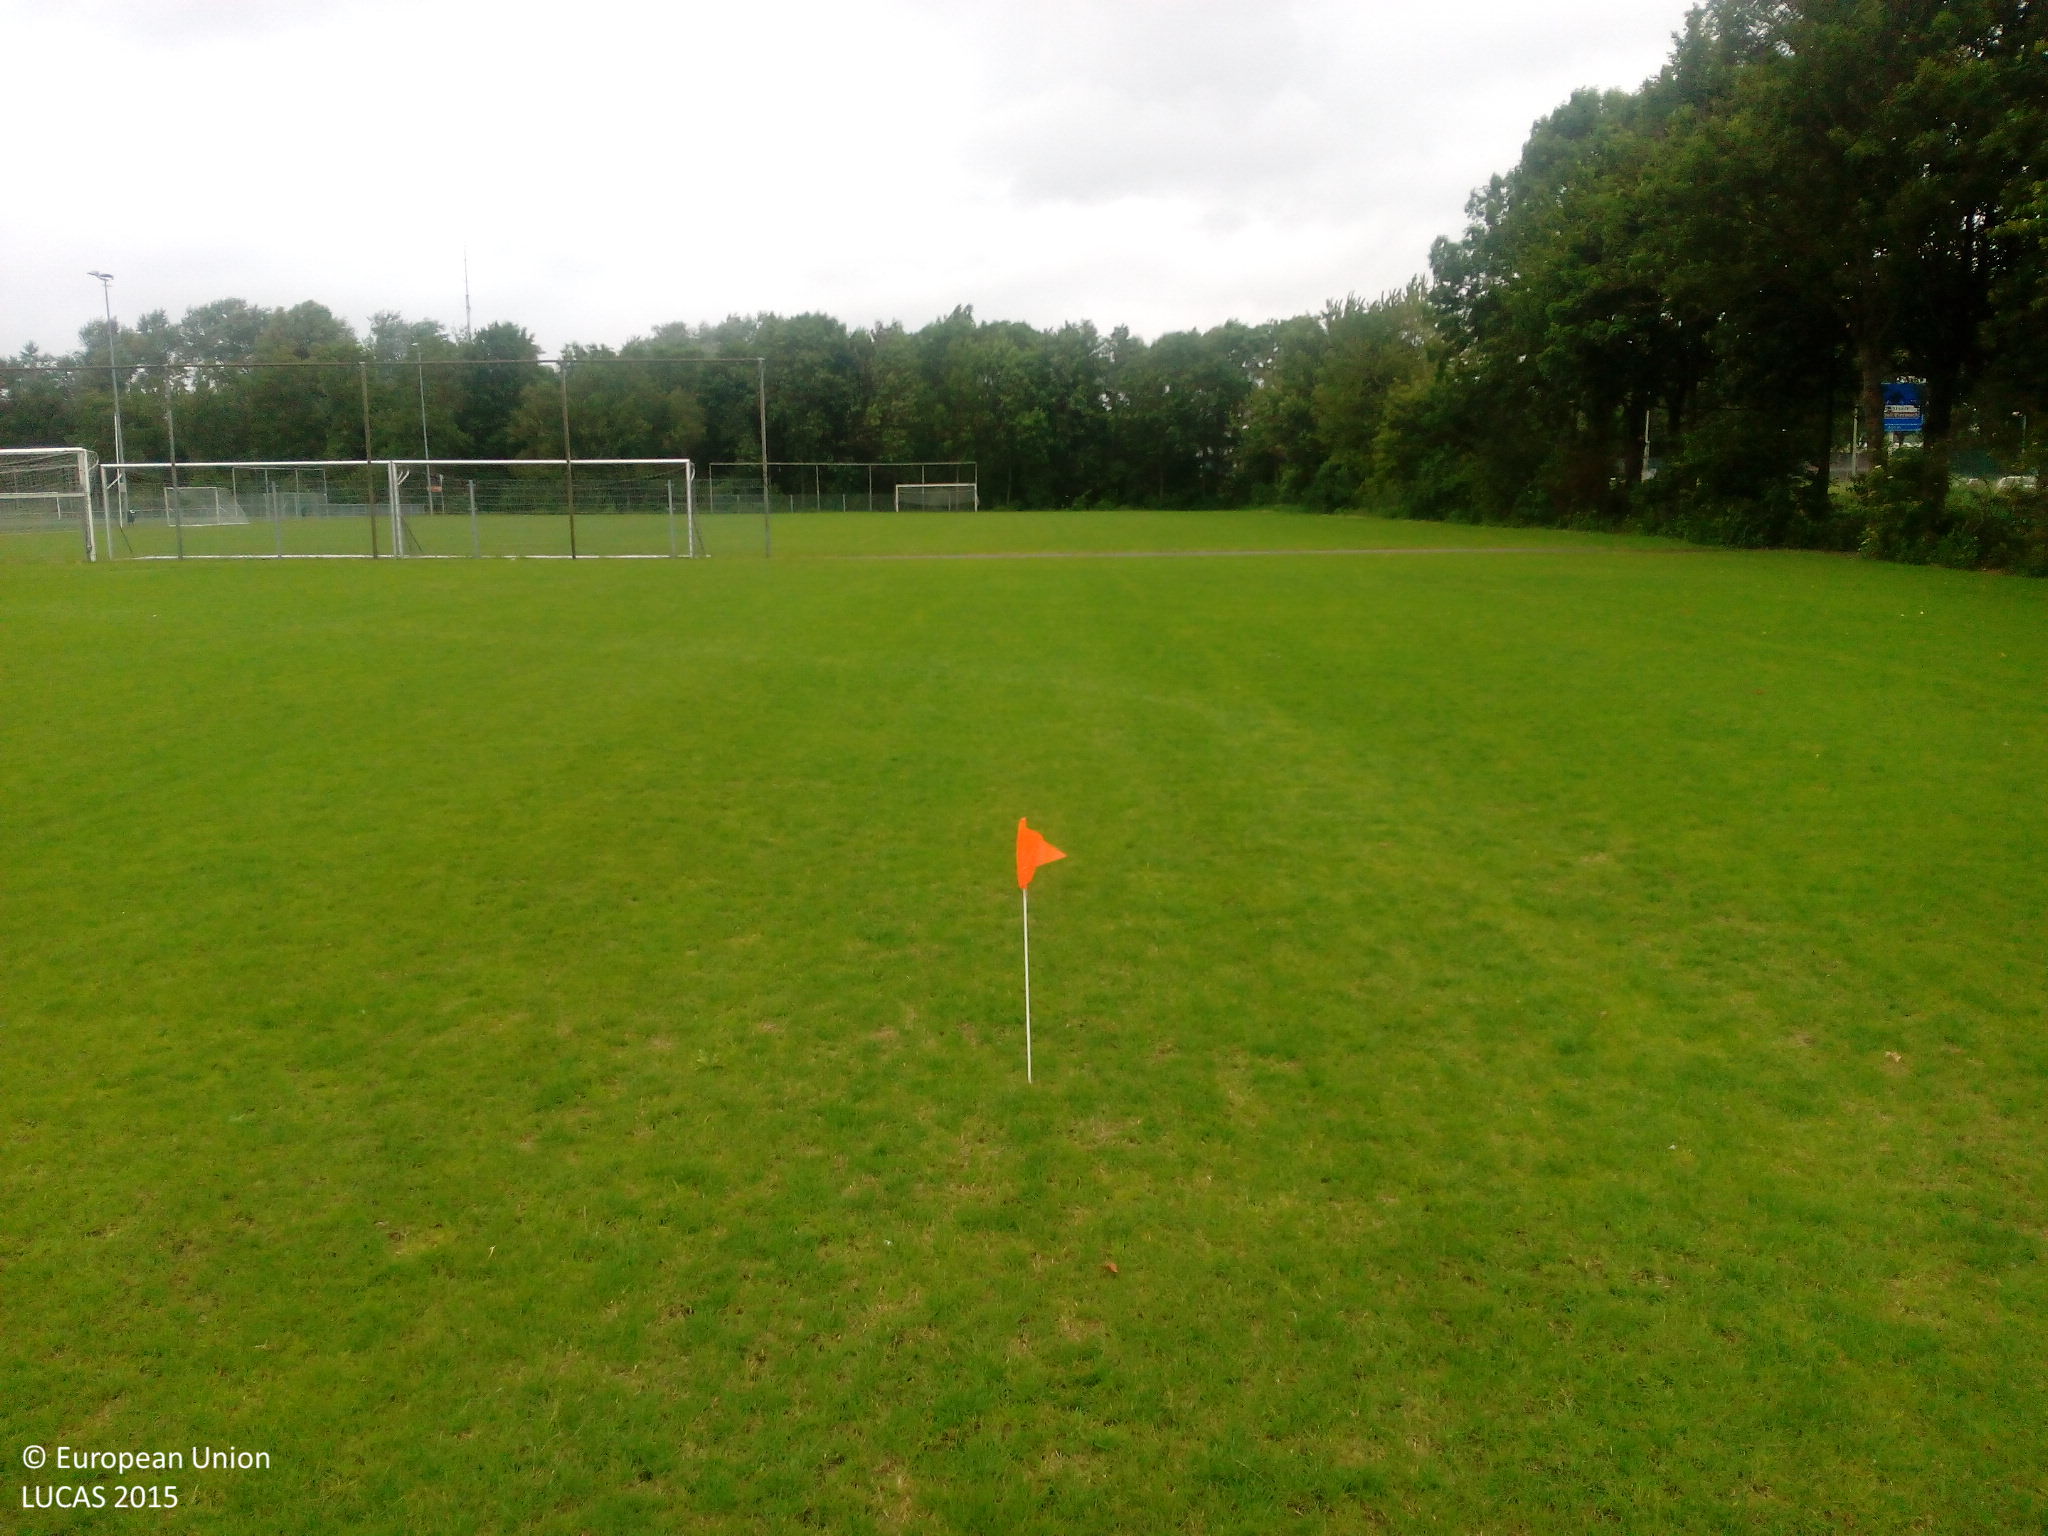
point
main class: Grassland
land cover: Grassland without tree/shrub cover
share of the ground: > 75 %
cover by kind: herbaceous plants 100 %
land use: Sport
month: June
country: NL
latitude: 51.8089
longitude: 4.7025
